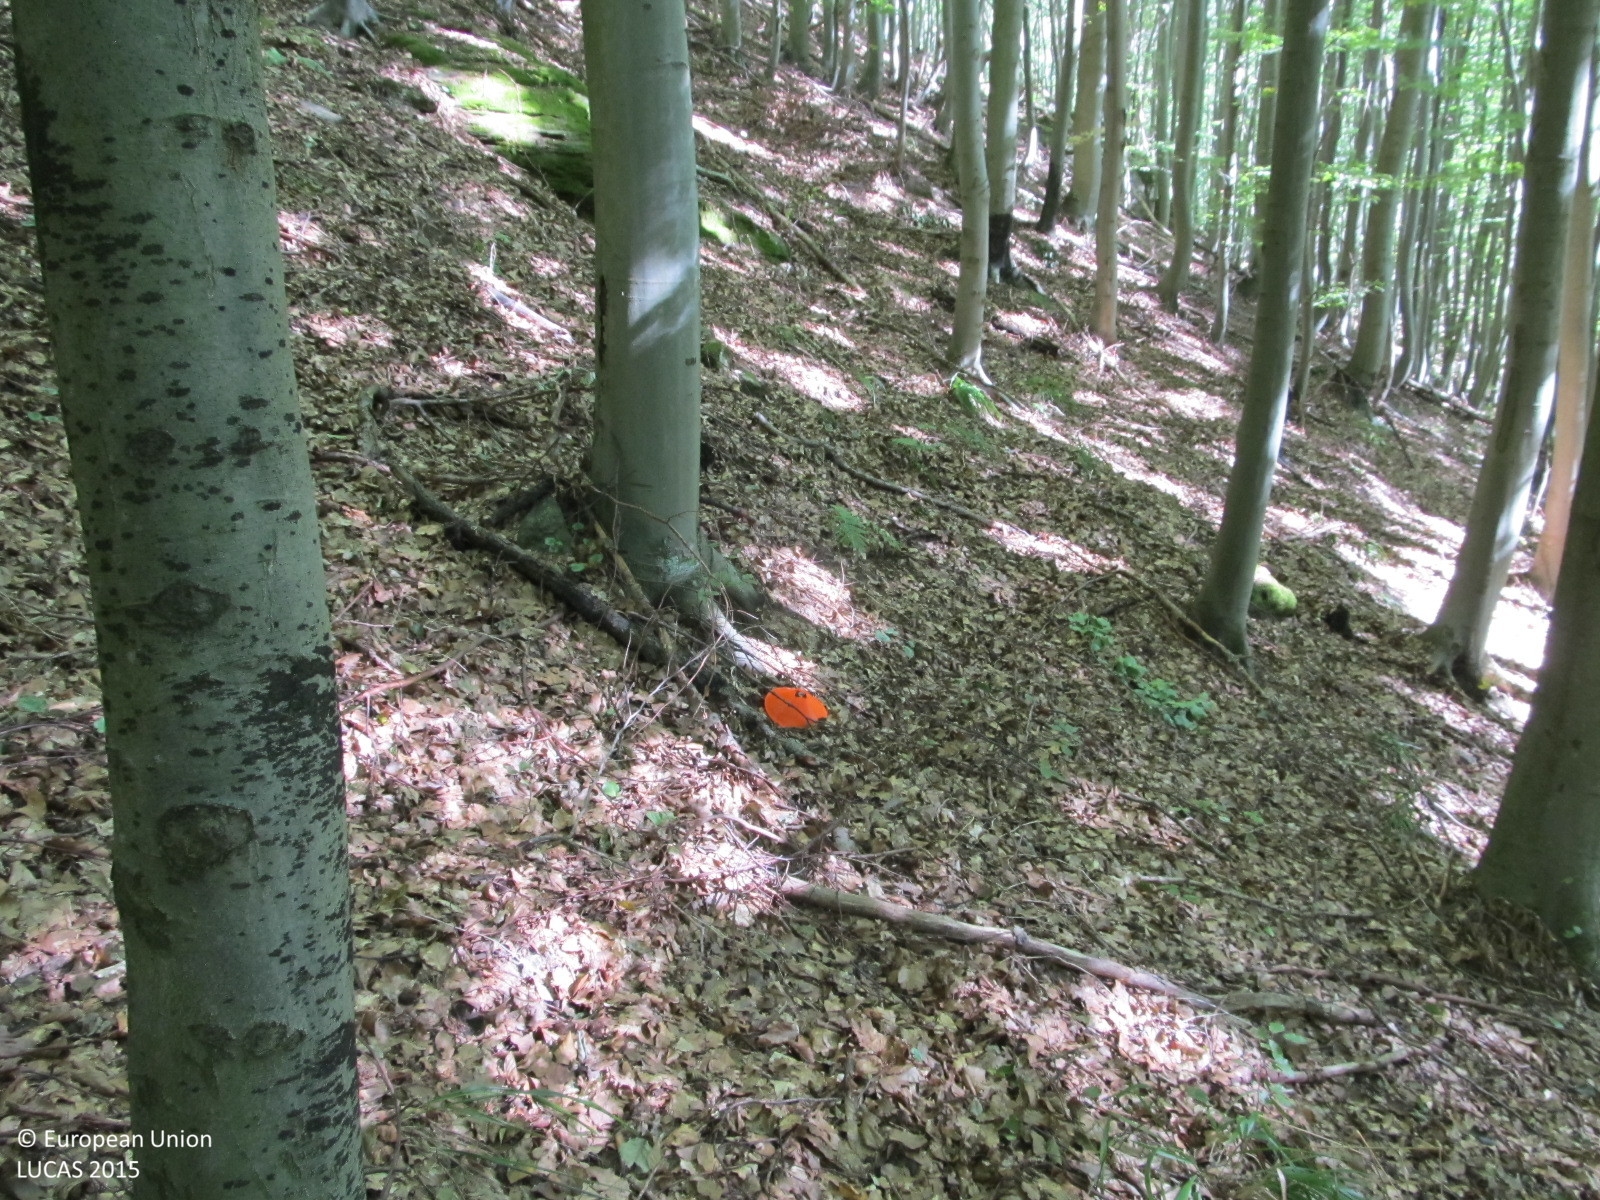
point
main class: Woodland
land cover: Broadleaved woodland
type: beech forest
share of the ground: > 75 %
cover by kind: broadleaved forest trees 85 %, unconsolidated bare surface 15 %
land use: Forestry
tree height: > 5 m
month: September
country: AT
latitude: 48.5005
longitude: 15.5111
